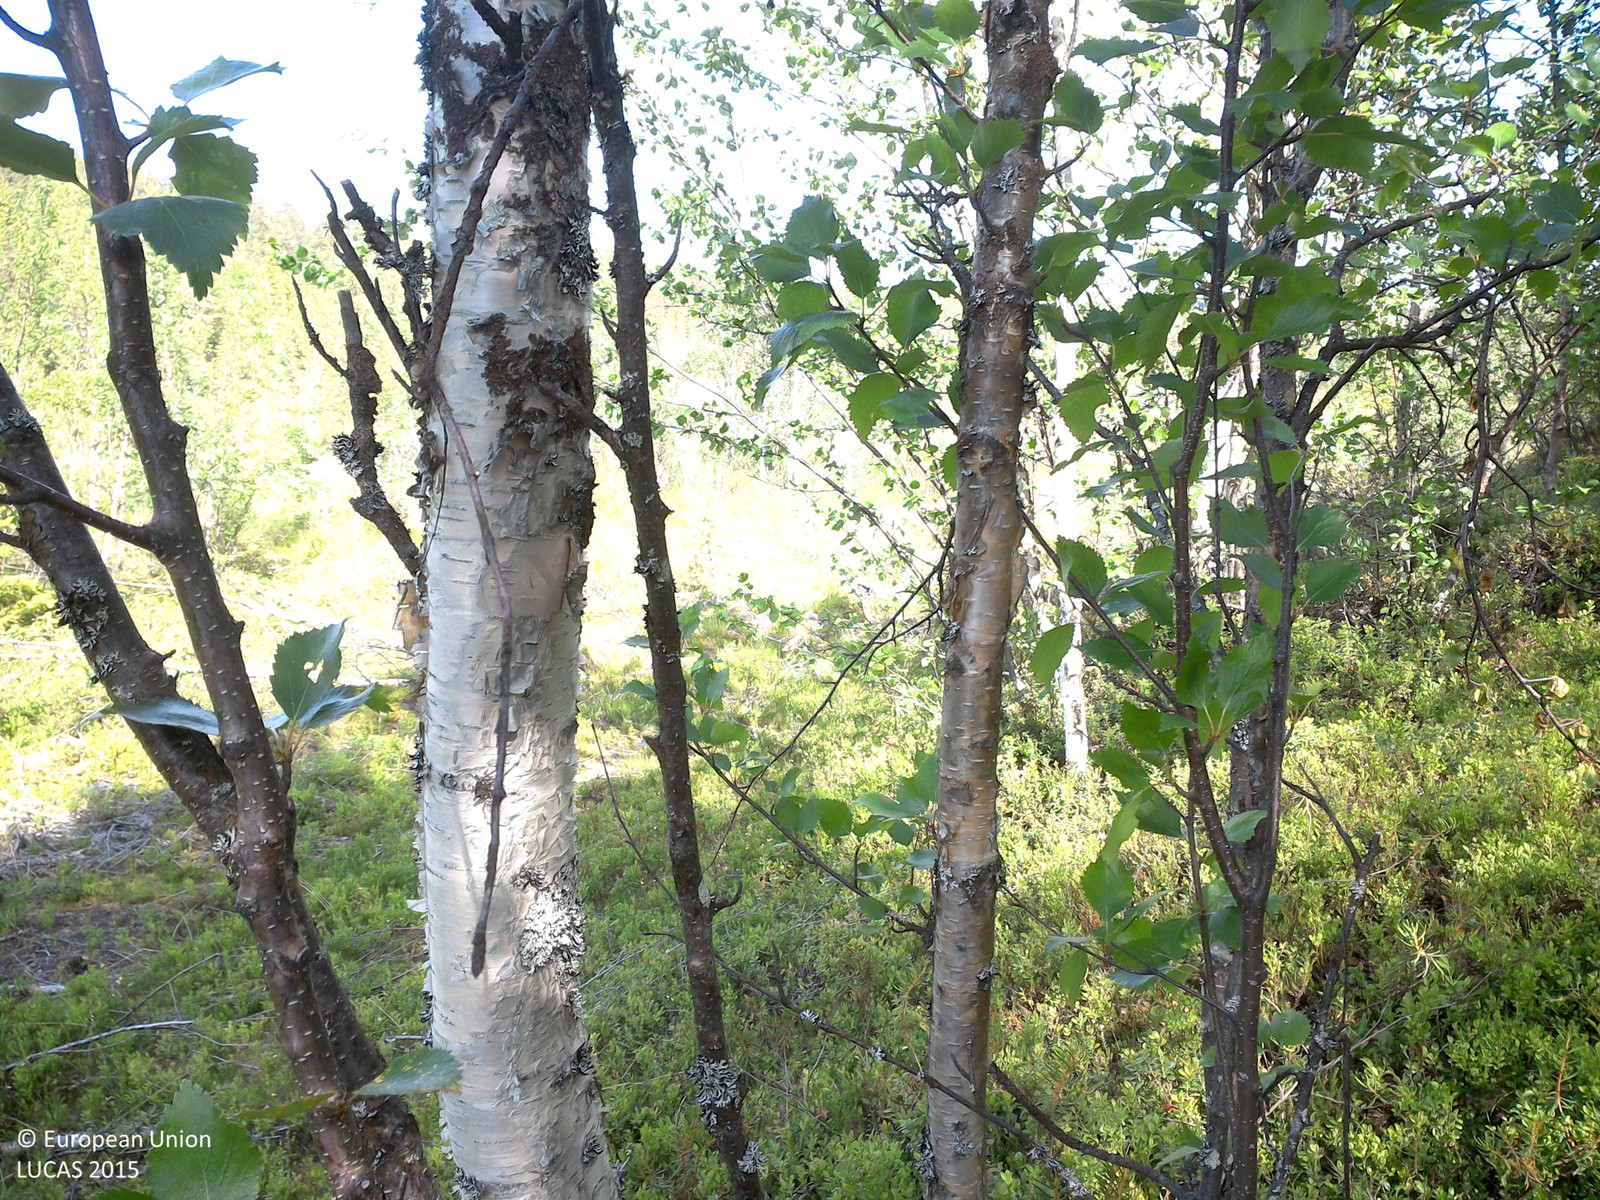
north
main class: Woodland
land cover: Pine dominated mixed woodland
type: boreal forest
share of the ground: 25 - 50 %
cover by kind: shrubs 70 %, coniferous forest trees 20 %, broadleaved forest trees 10 %
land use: Forestry
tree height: > 5 m
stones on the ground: < 10 %
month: July
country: SE
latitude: 67.7268
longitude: 22.1747
